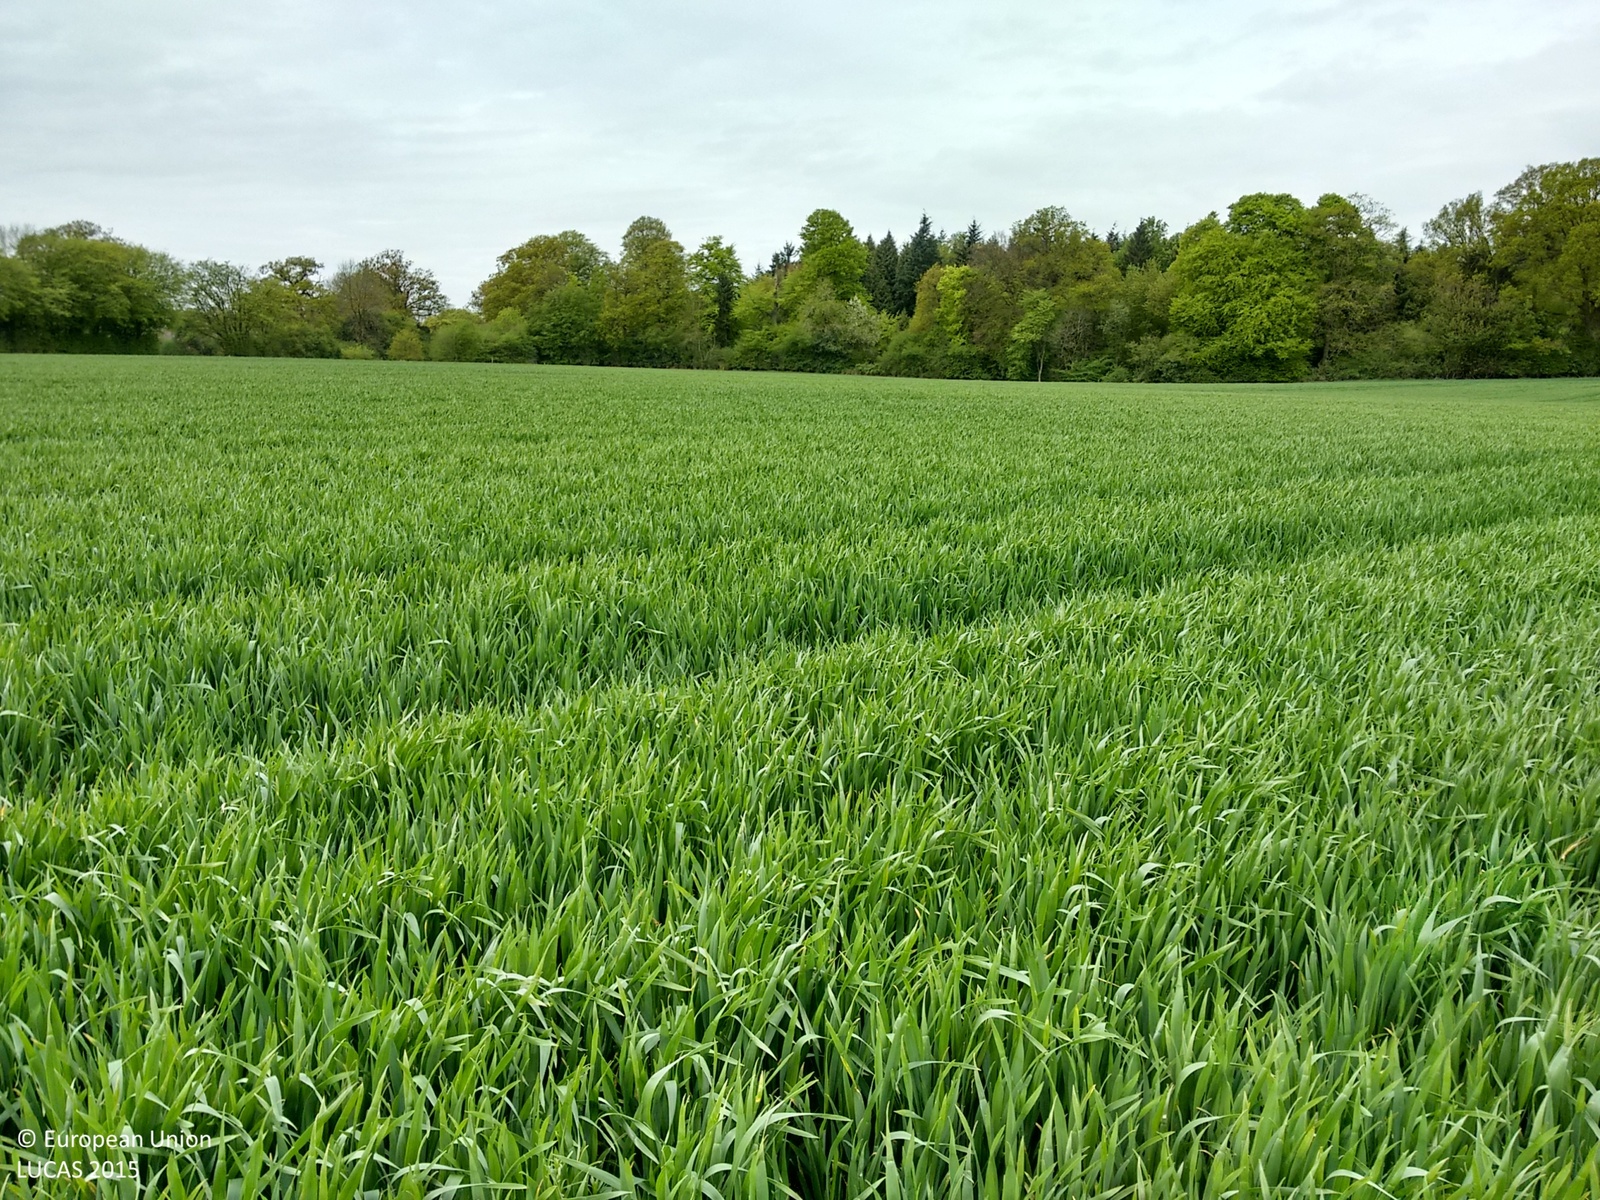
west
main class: Cropland
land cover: Common wheat
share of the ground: > 75 %
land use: Agriculture (excluding fallow land and kitchen gardens)
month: May
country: GB
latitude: 51.7563
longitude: -0.6006
